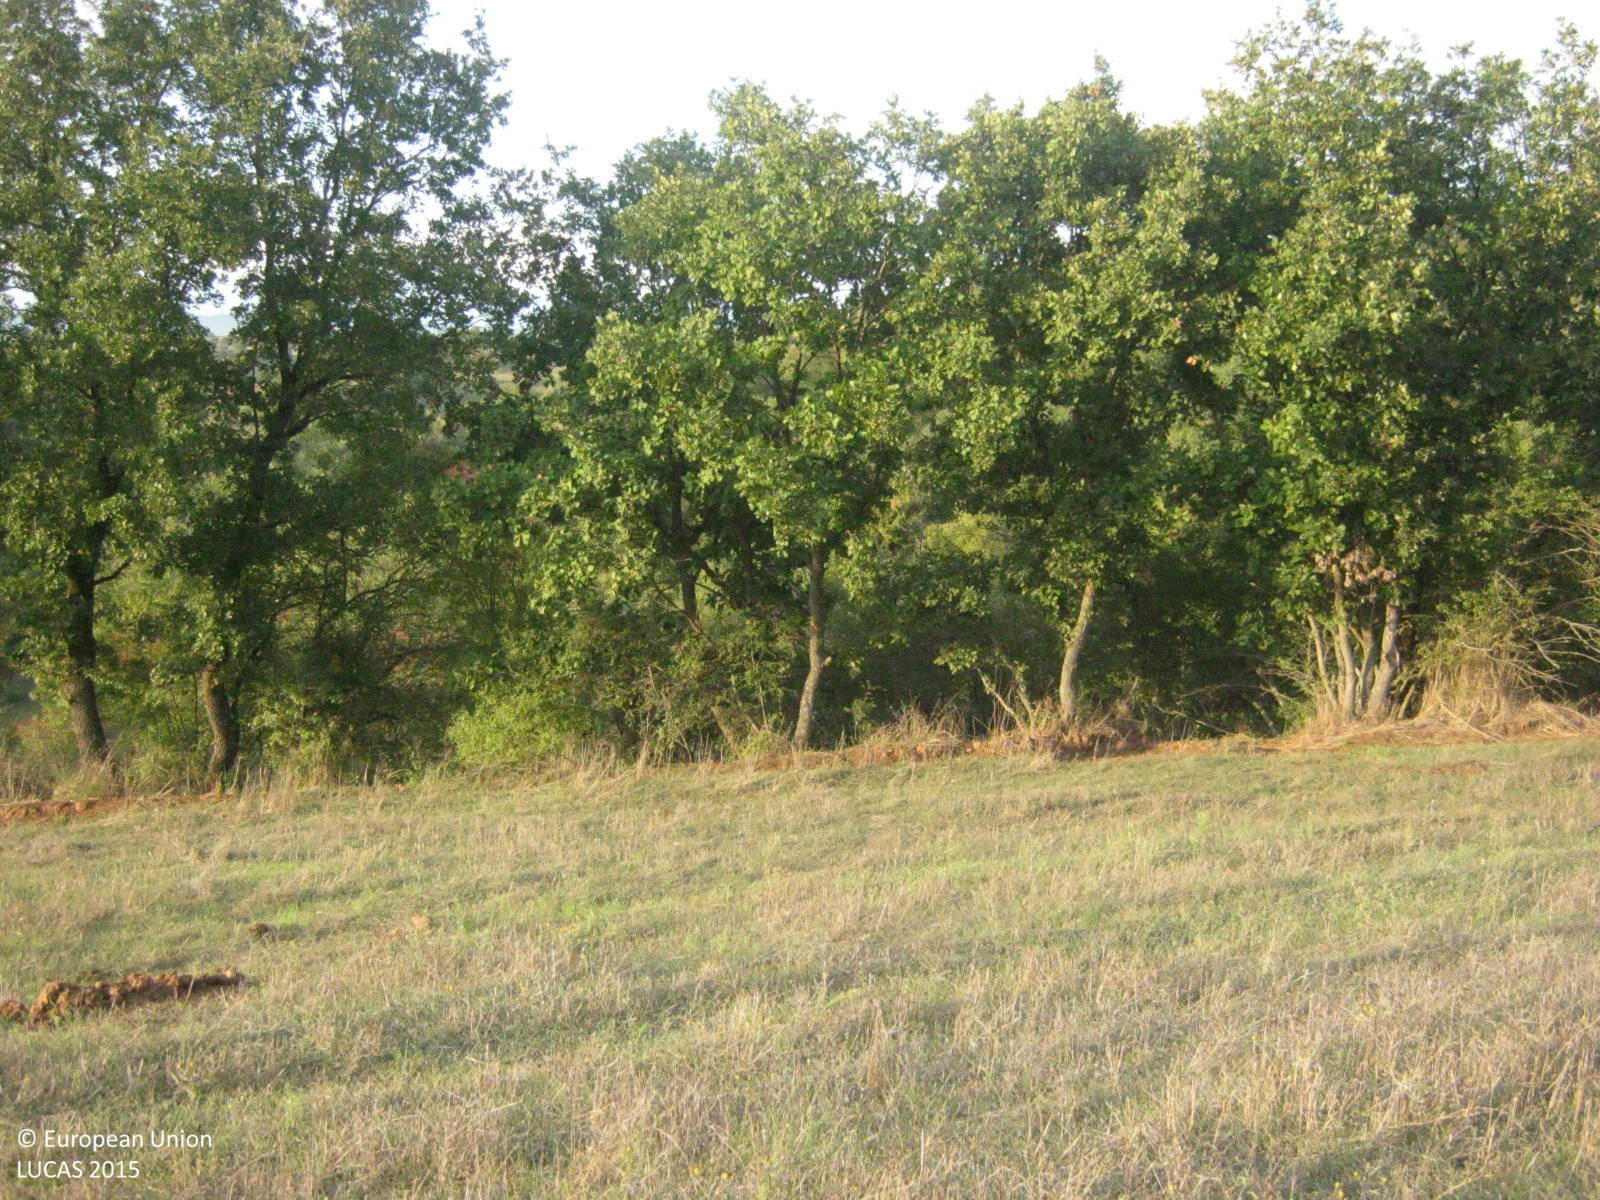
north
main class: Cropland
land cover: Common wheat
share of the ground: > 75 %
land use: Agriculture (excluding fallow land and kitchen gardens)
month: September
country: GR
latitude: 41.0458
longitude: 22.9917
